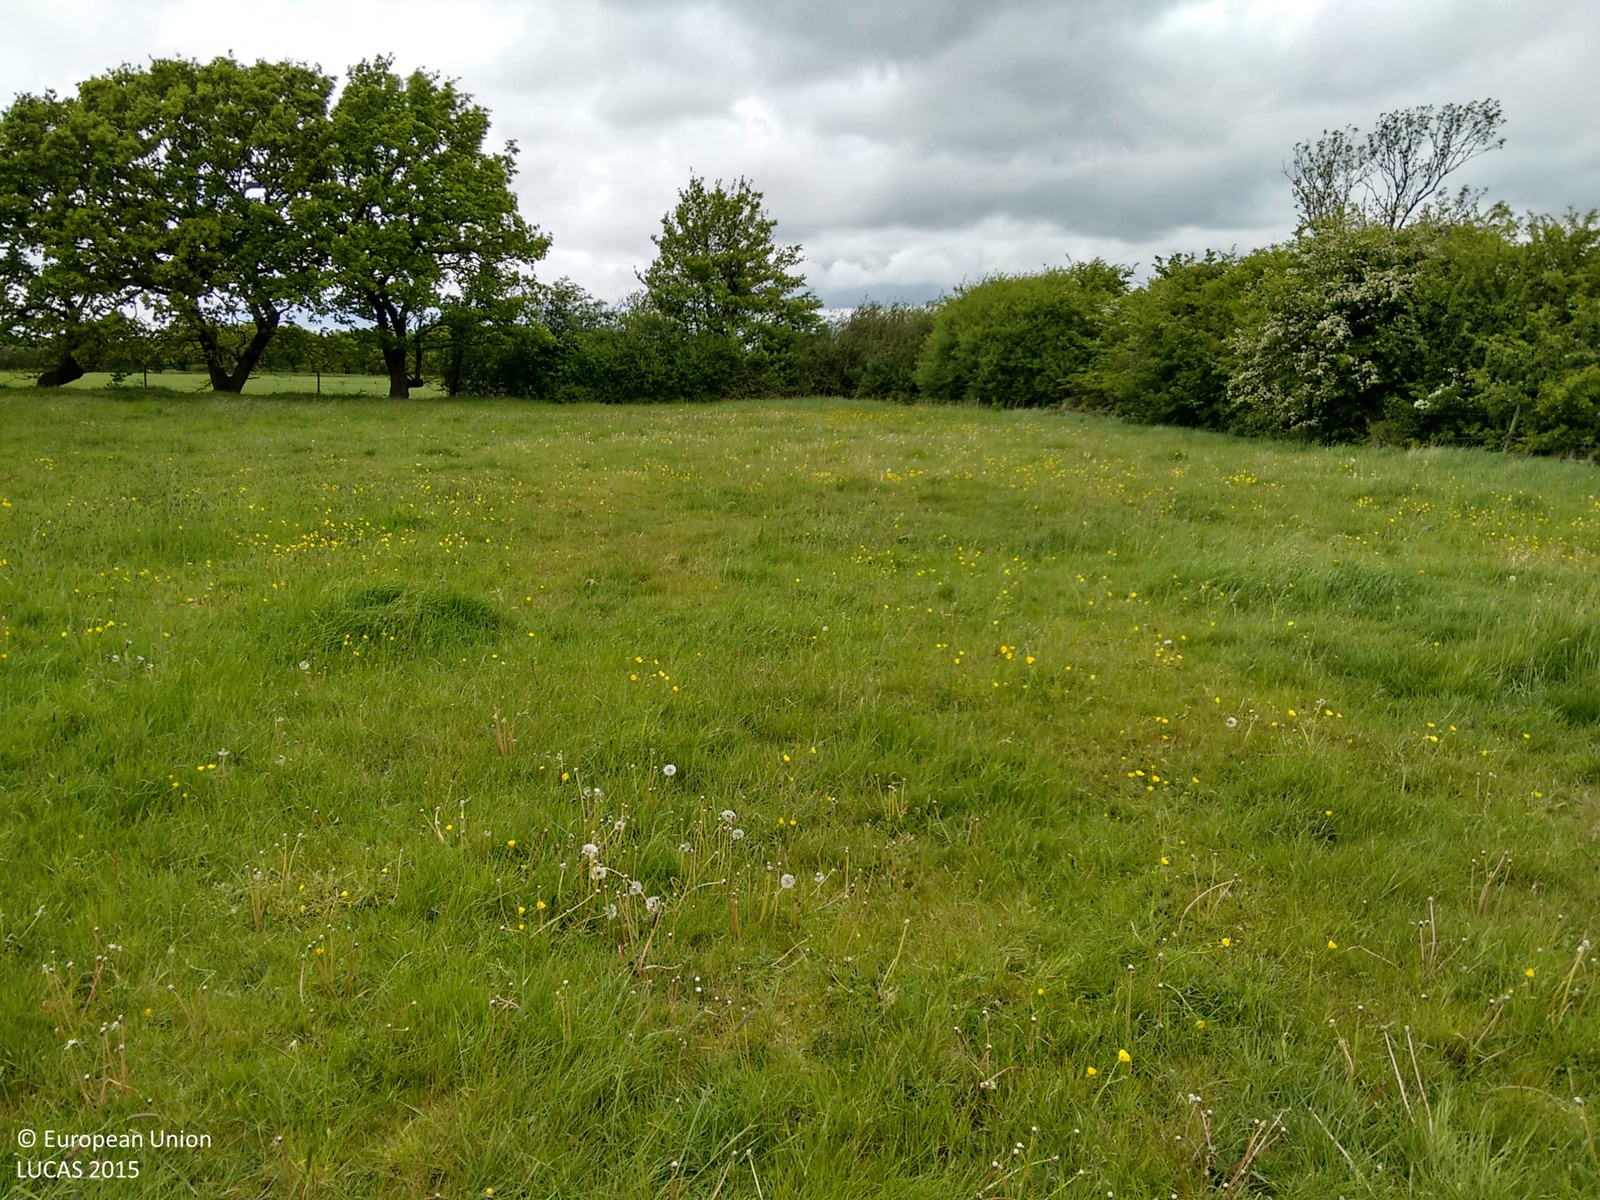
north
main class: Grassland
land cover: Grassland without tree/shrub cover
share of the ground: > 75 %
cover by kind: herbaceous plants 100 %
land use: Agriculture (excluding fallow land and kitchen gardens)
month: May
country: GB
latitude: 53.6397
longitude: -1.0398
